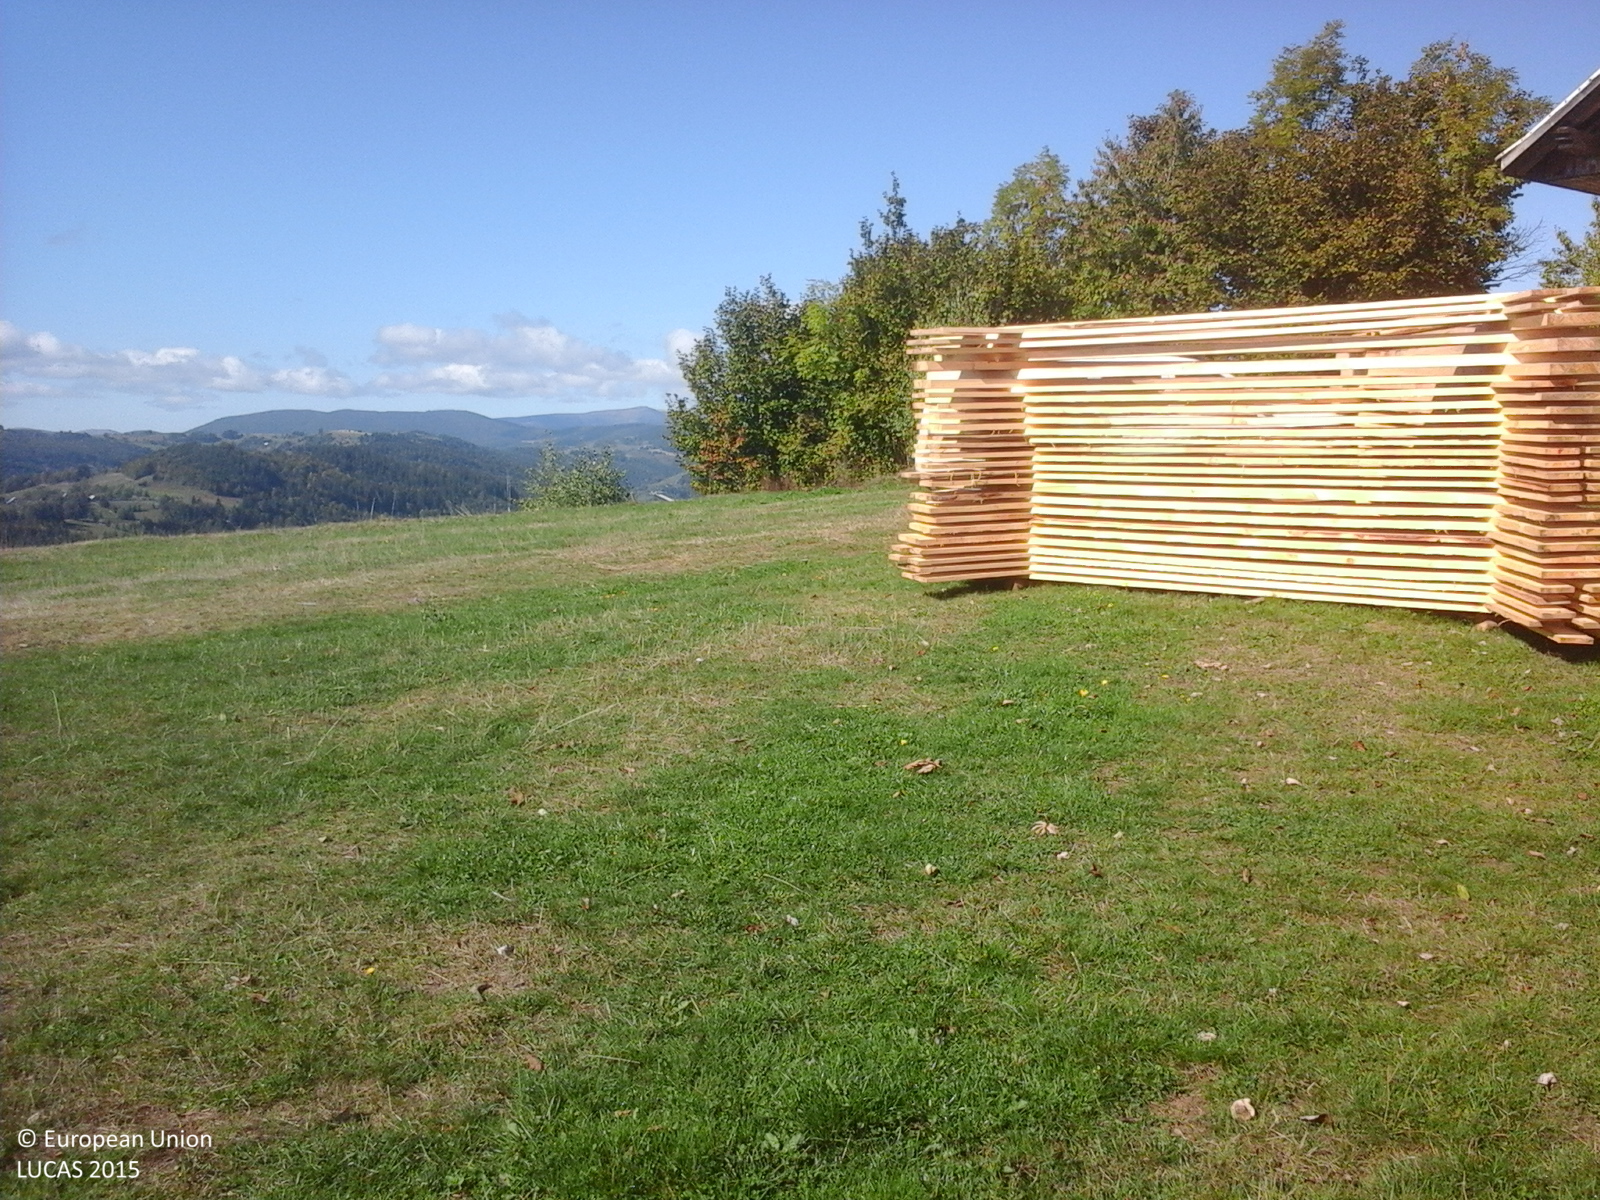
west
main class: Cropland
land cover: Apple fruit
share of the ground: > 75 %
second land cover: Grassland without tree/shrub cover
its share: > 75 %
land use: Agriculture (excluding fallow land and kitchen gardens)
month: October
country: RO
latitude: 46.4168
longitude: 22.9513
